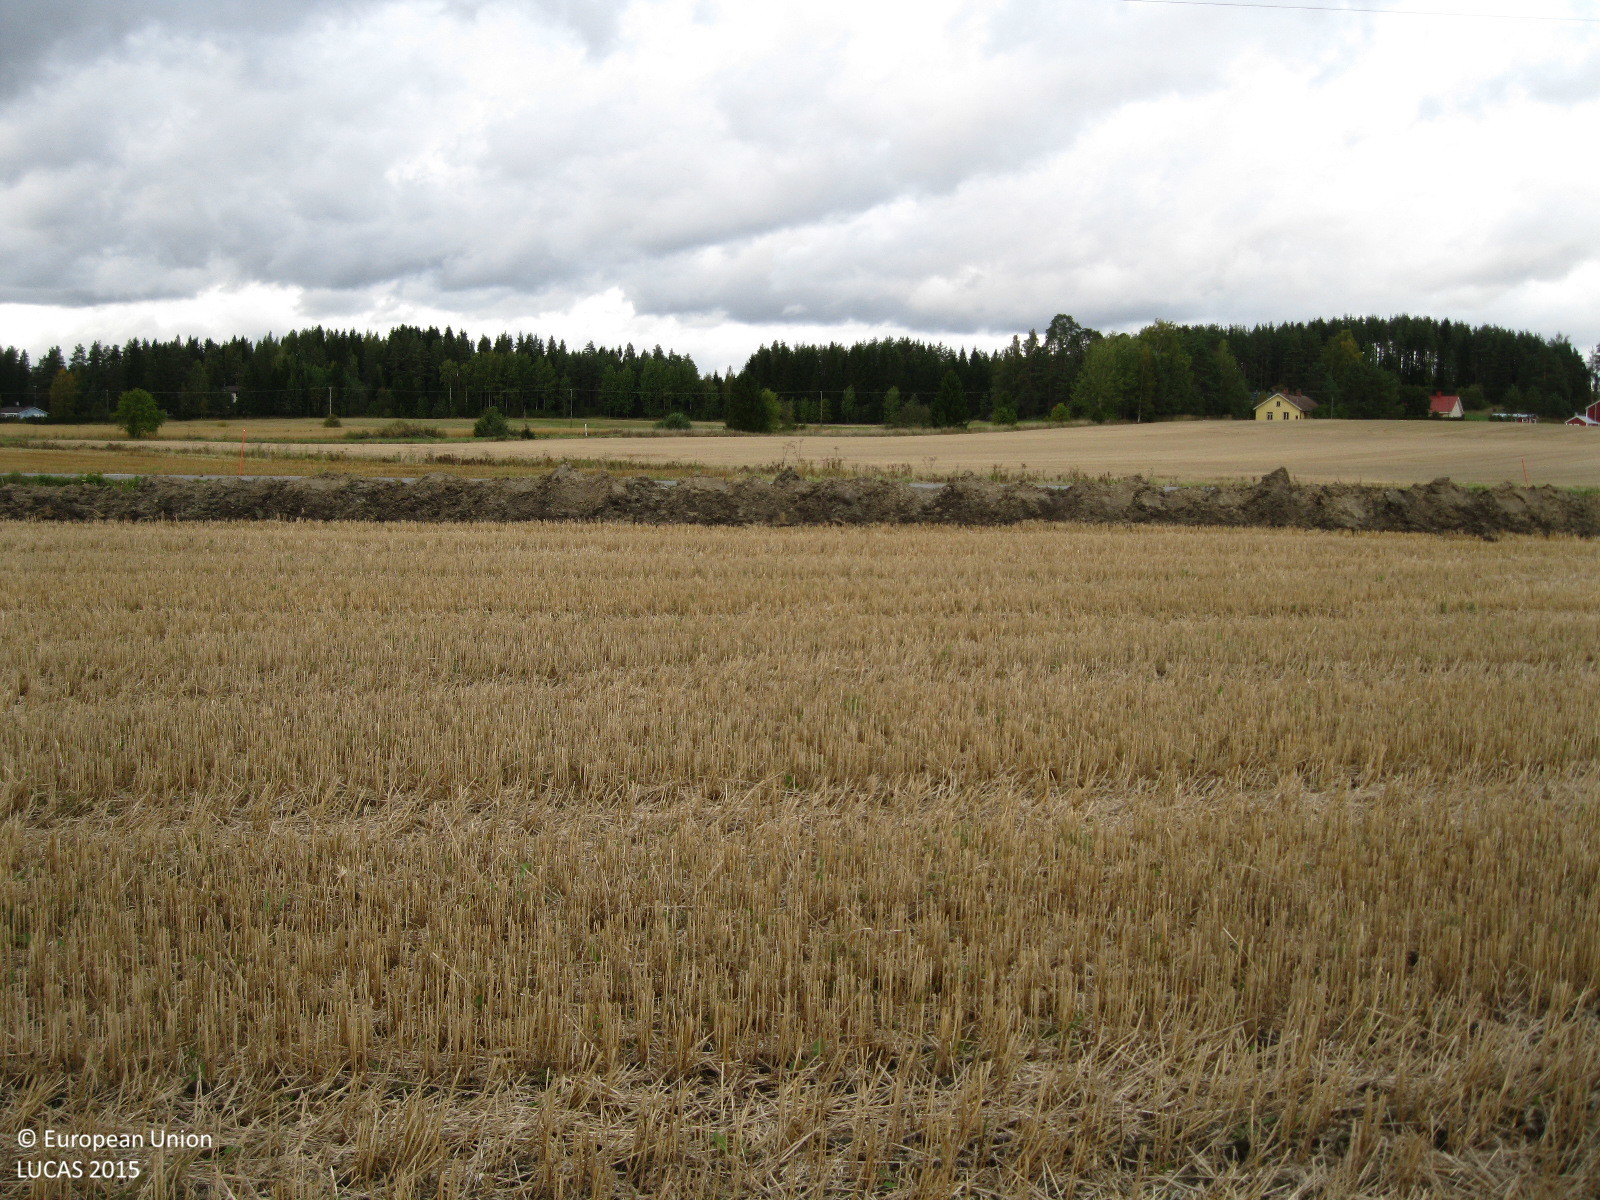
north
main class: Cropland
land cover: Barley
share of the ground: > 75 %
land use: Agriculture (excluding fallow land and kitchen gardens)
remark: Harvested field
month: September
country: FI
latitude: 60.6746
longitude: 24.8473
